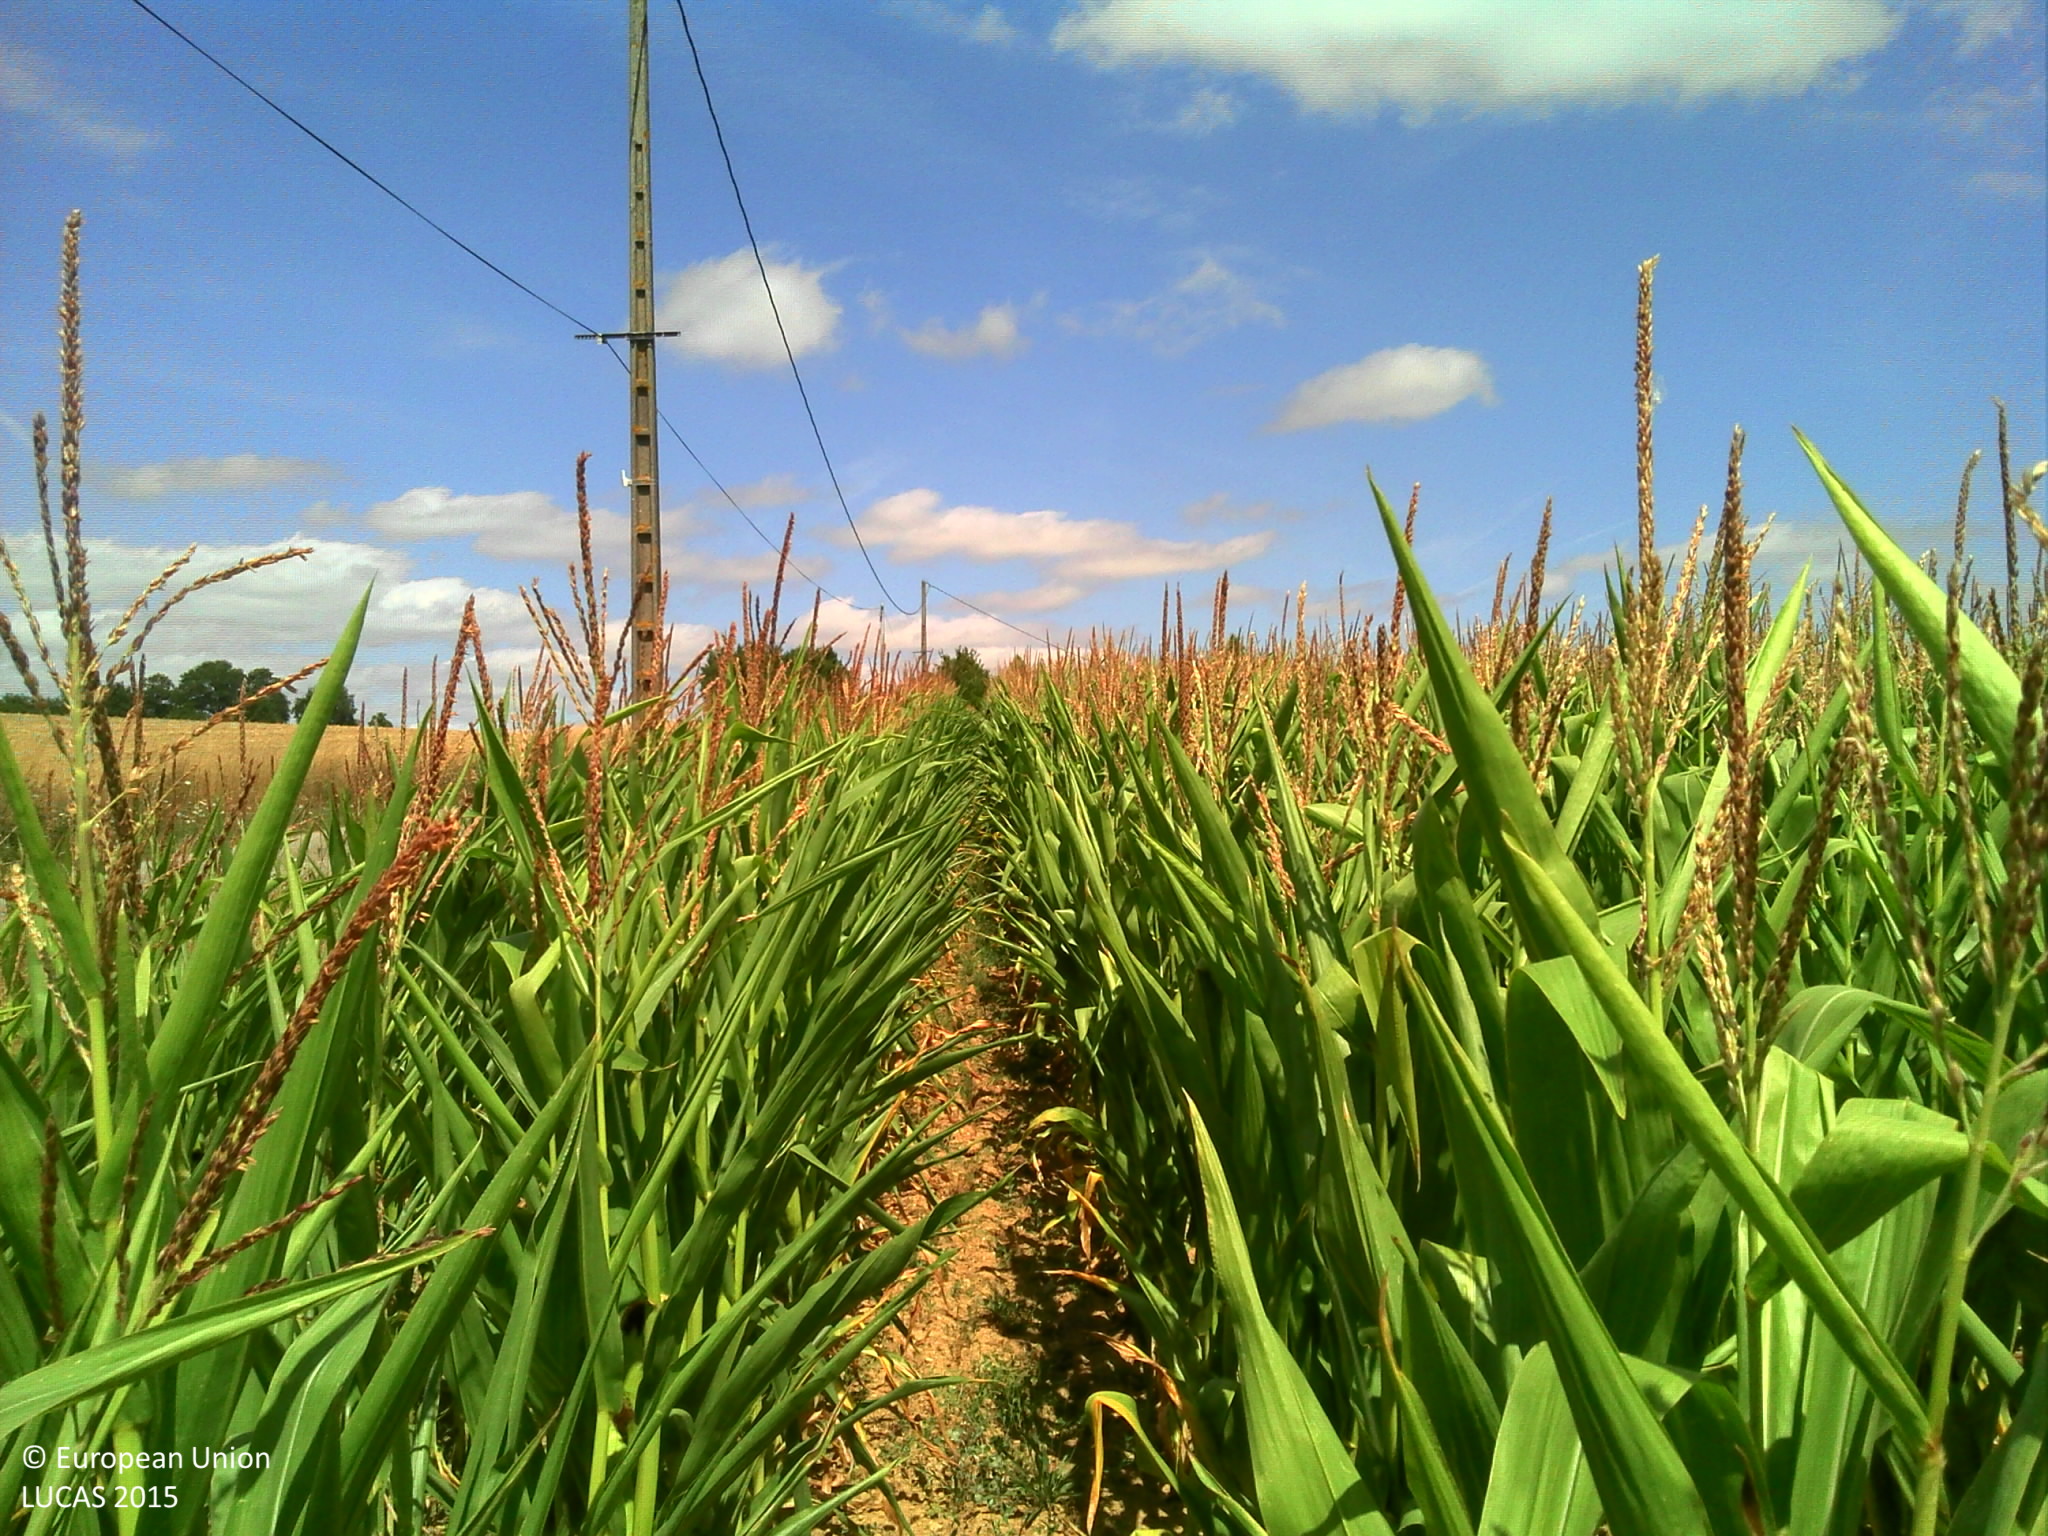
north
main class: Cropland
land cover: Maize
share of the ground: > 75 %
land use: Agriculture (excluding fallow land and kitchen gardens)
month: August
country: FR
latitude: 47.8206
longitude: -1.1390
